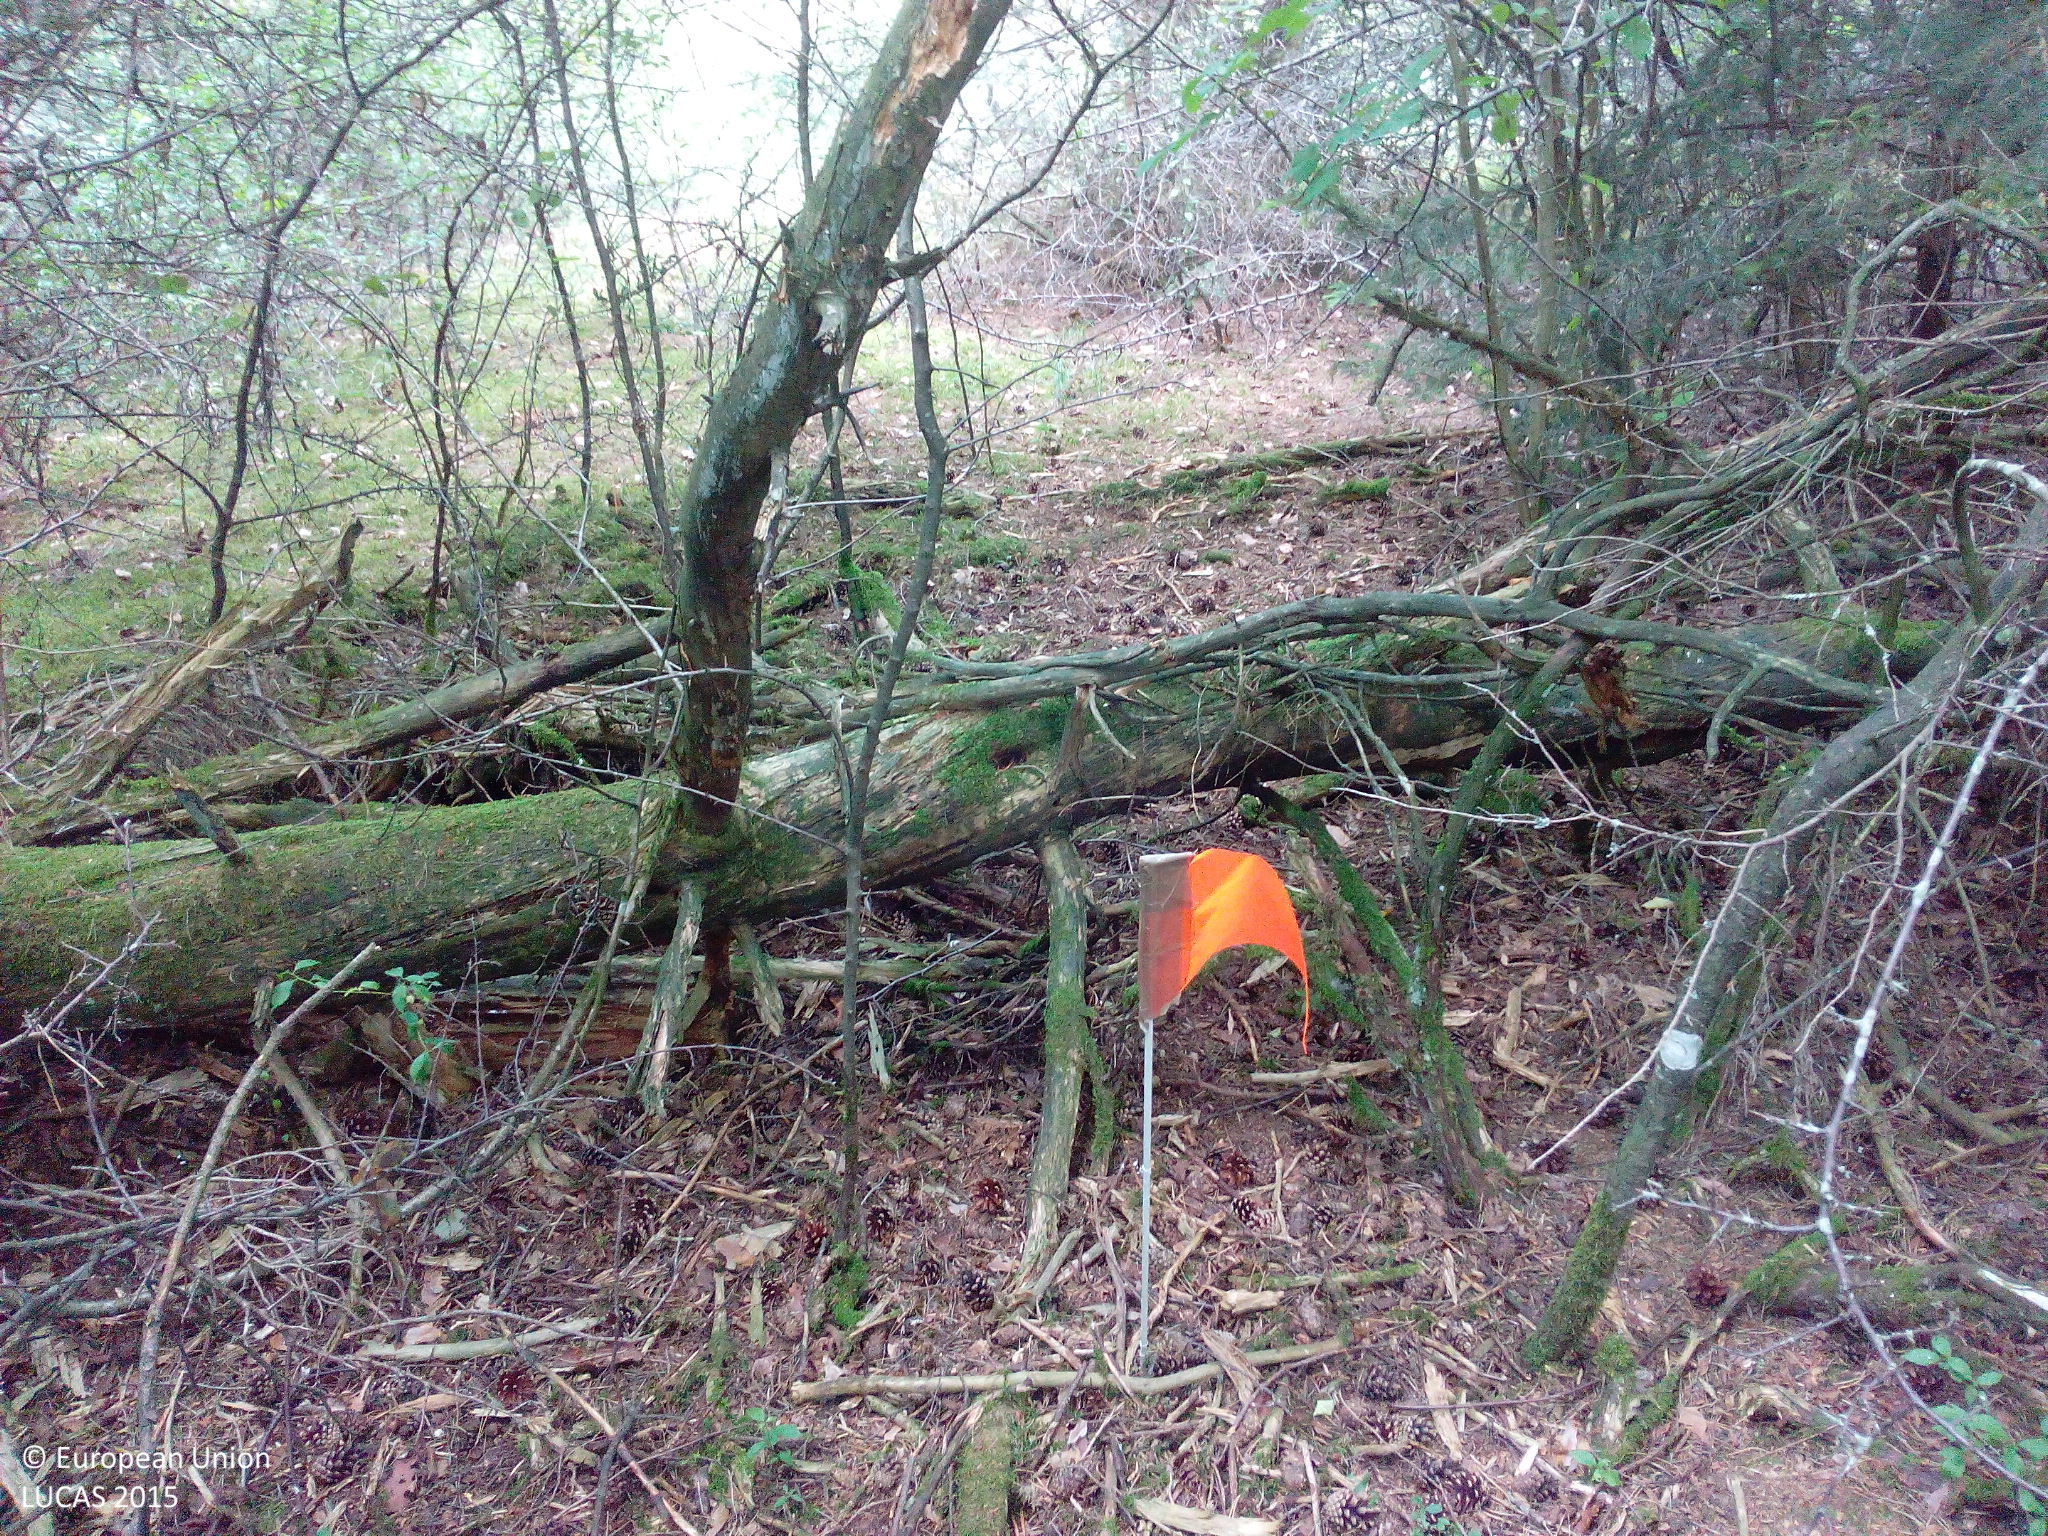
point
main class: Woodland
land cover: Spruce dominated mixed woodland
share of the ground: > 75 %
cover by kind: broadleaved forest trees 55 %, coniferous forest trees 35 %, shrubs 10 %
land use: Semi-natural and natural areas not in use
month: July
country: DE
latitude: 48.4030
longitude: 9.6895
